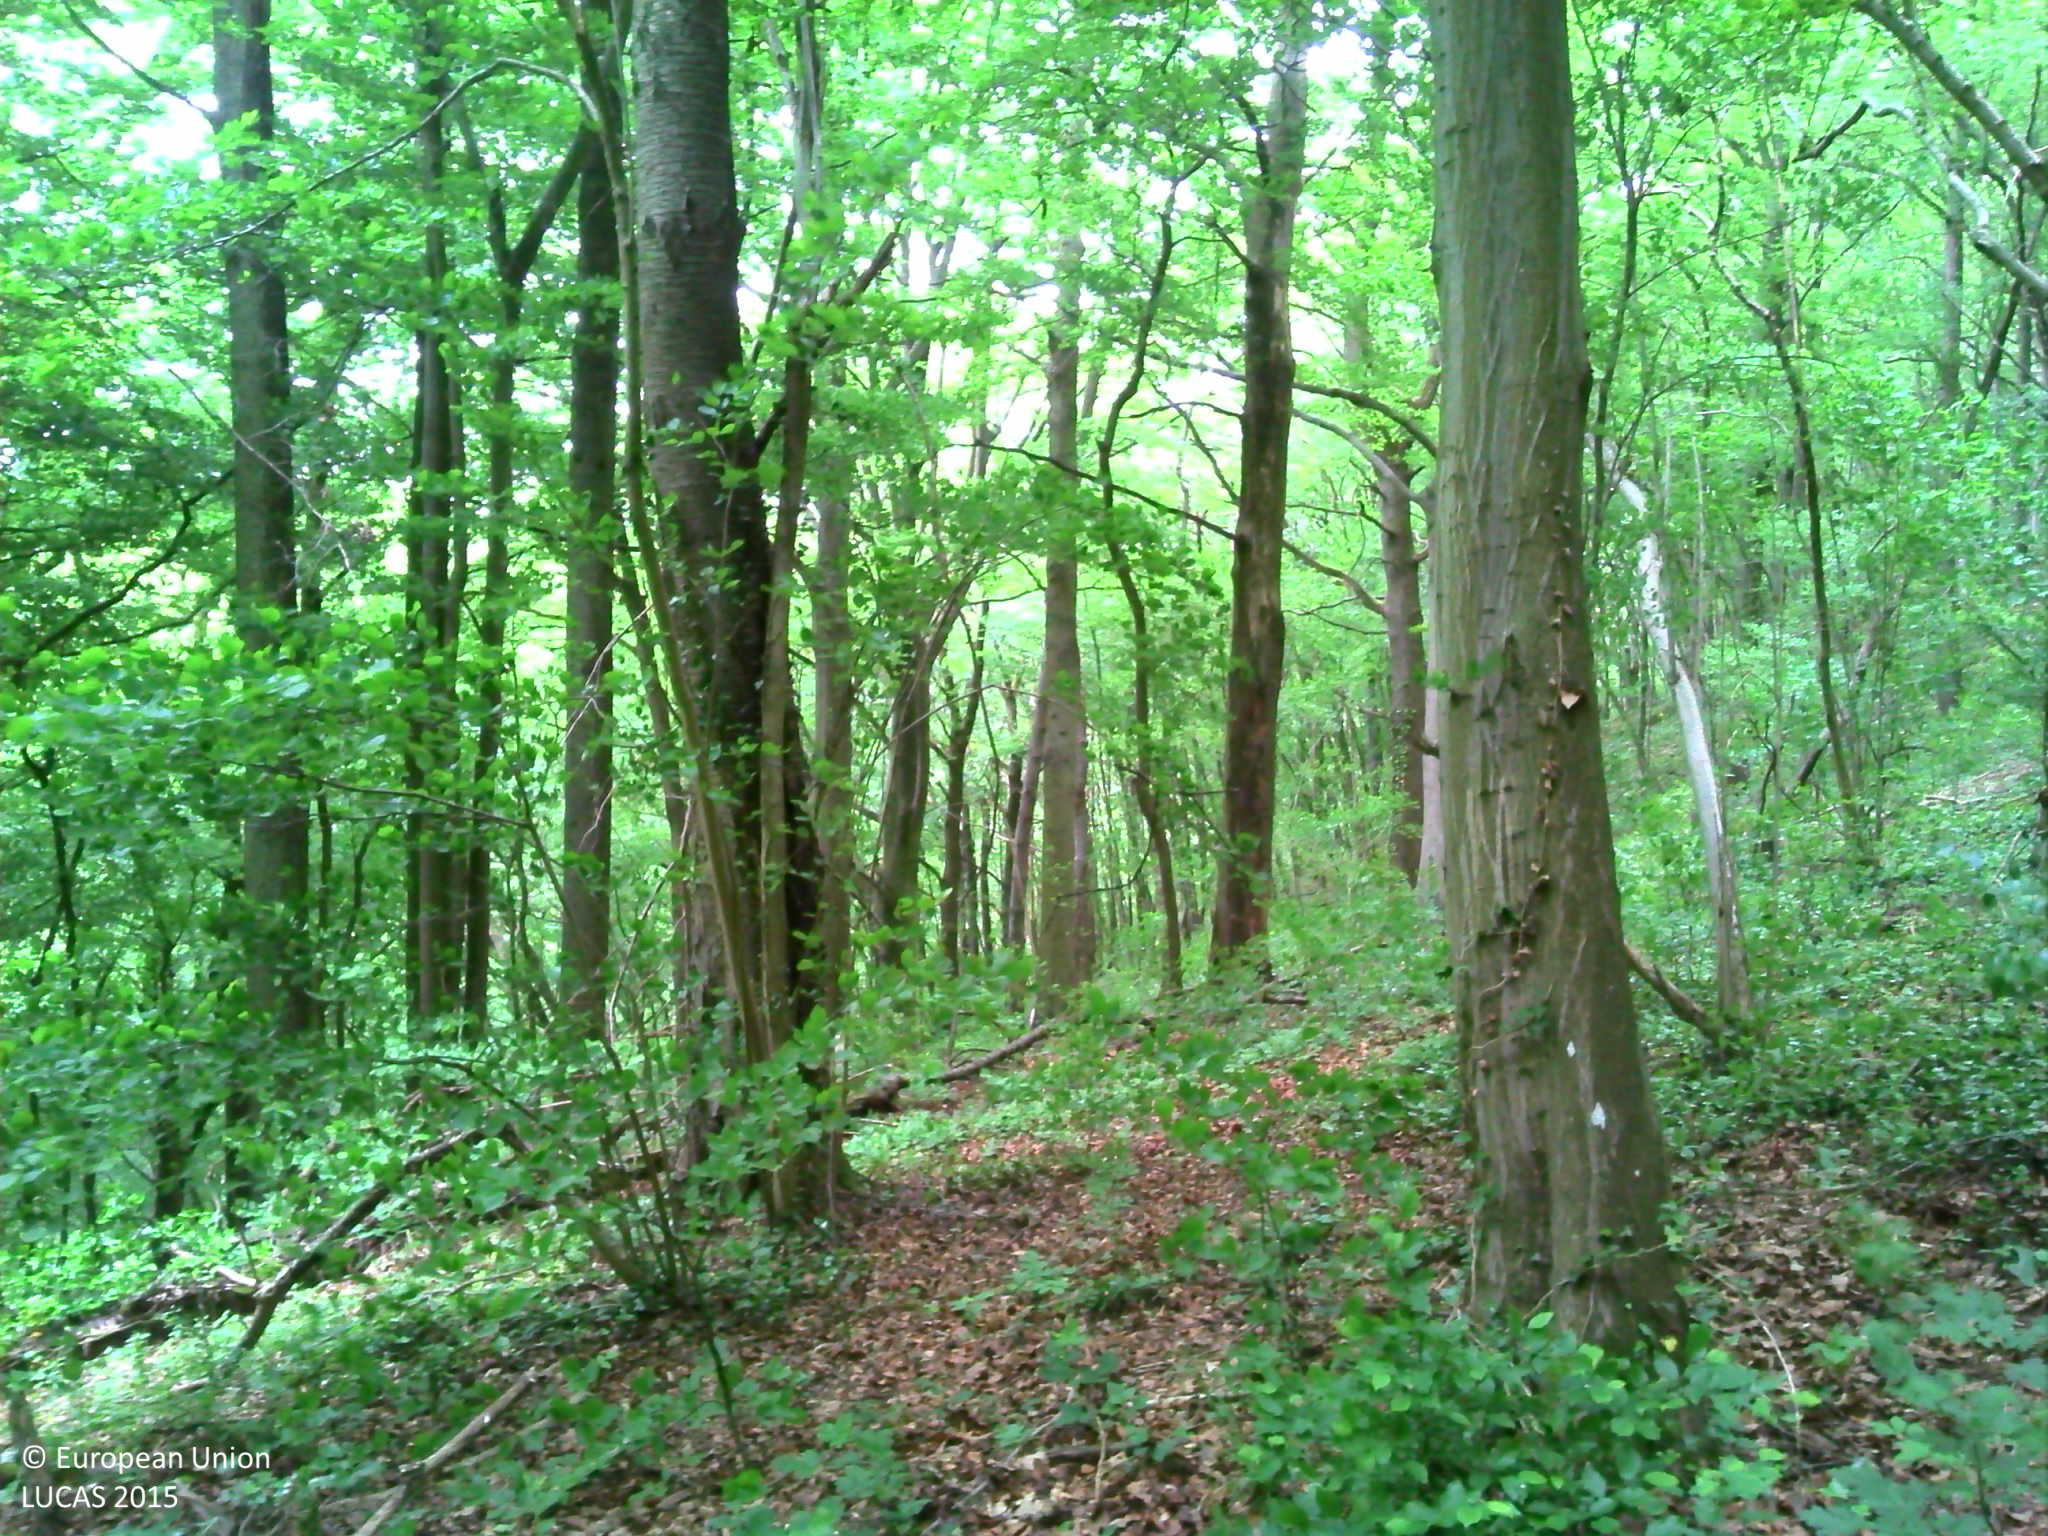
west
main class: Woodland
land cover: Broadleaved woodland
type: acidophilous oak and oak-birch forest
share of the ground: > 75 %
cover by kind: broadleaved forest trees 90 %, herbaceous plants 10 %
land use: Forestry
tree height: > 5 m
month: June
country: BE
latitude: 50.4031
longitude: 5.5383
